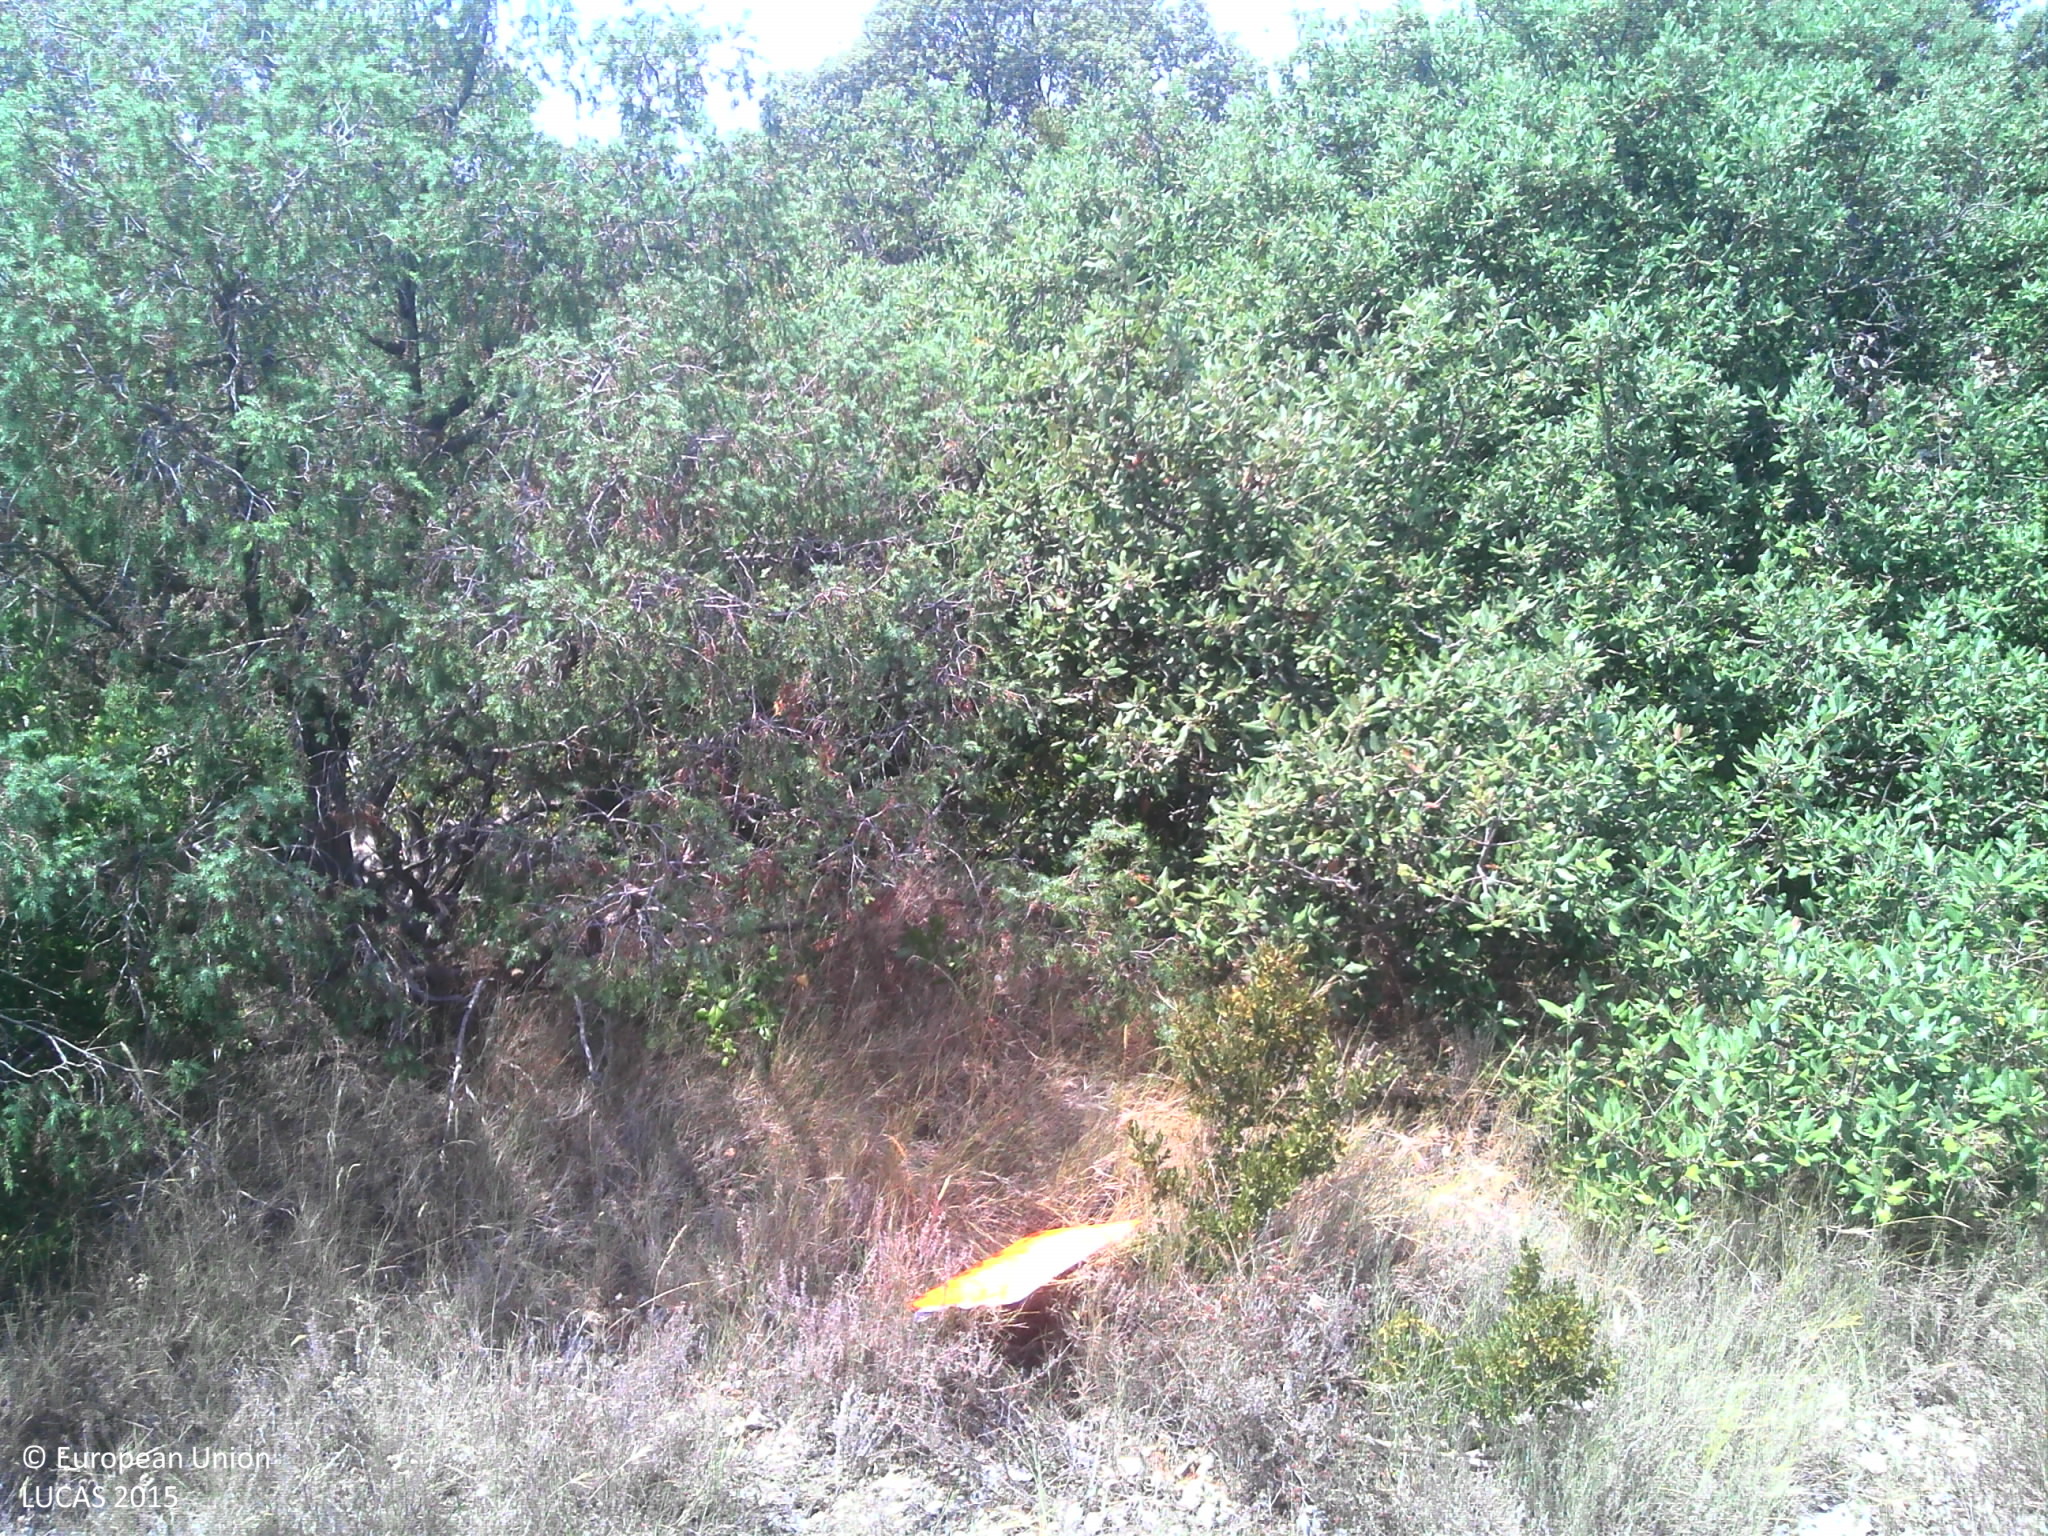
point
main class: Shrubland
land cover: Shrubland with sparse tree cover
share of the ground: > 75 %
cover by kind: shrubs 70 %, herbaceous plants 25 %, broadleaved forest trees 5 %
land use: Semi-natural and natural areas not in use
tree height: < 5 m
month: July
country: FR
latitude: 44.3546
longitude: 4.6000
